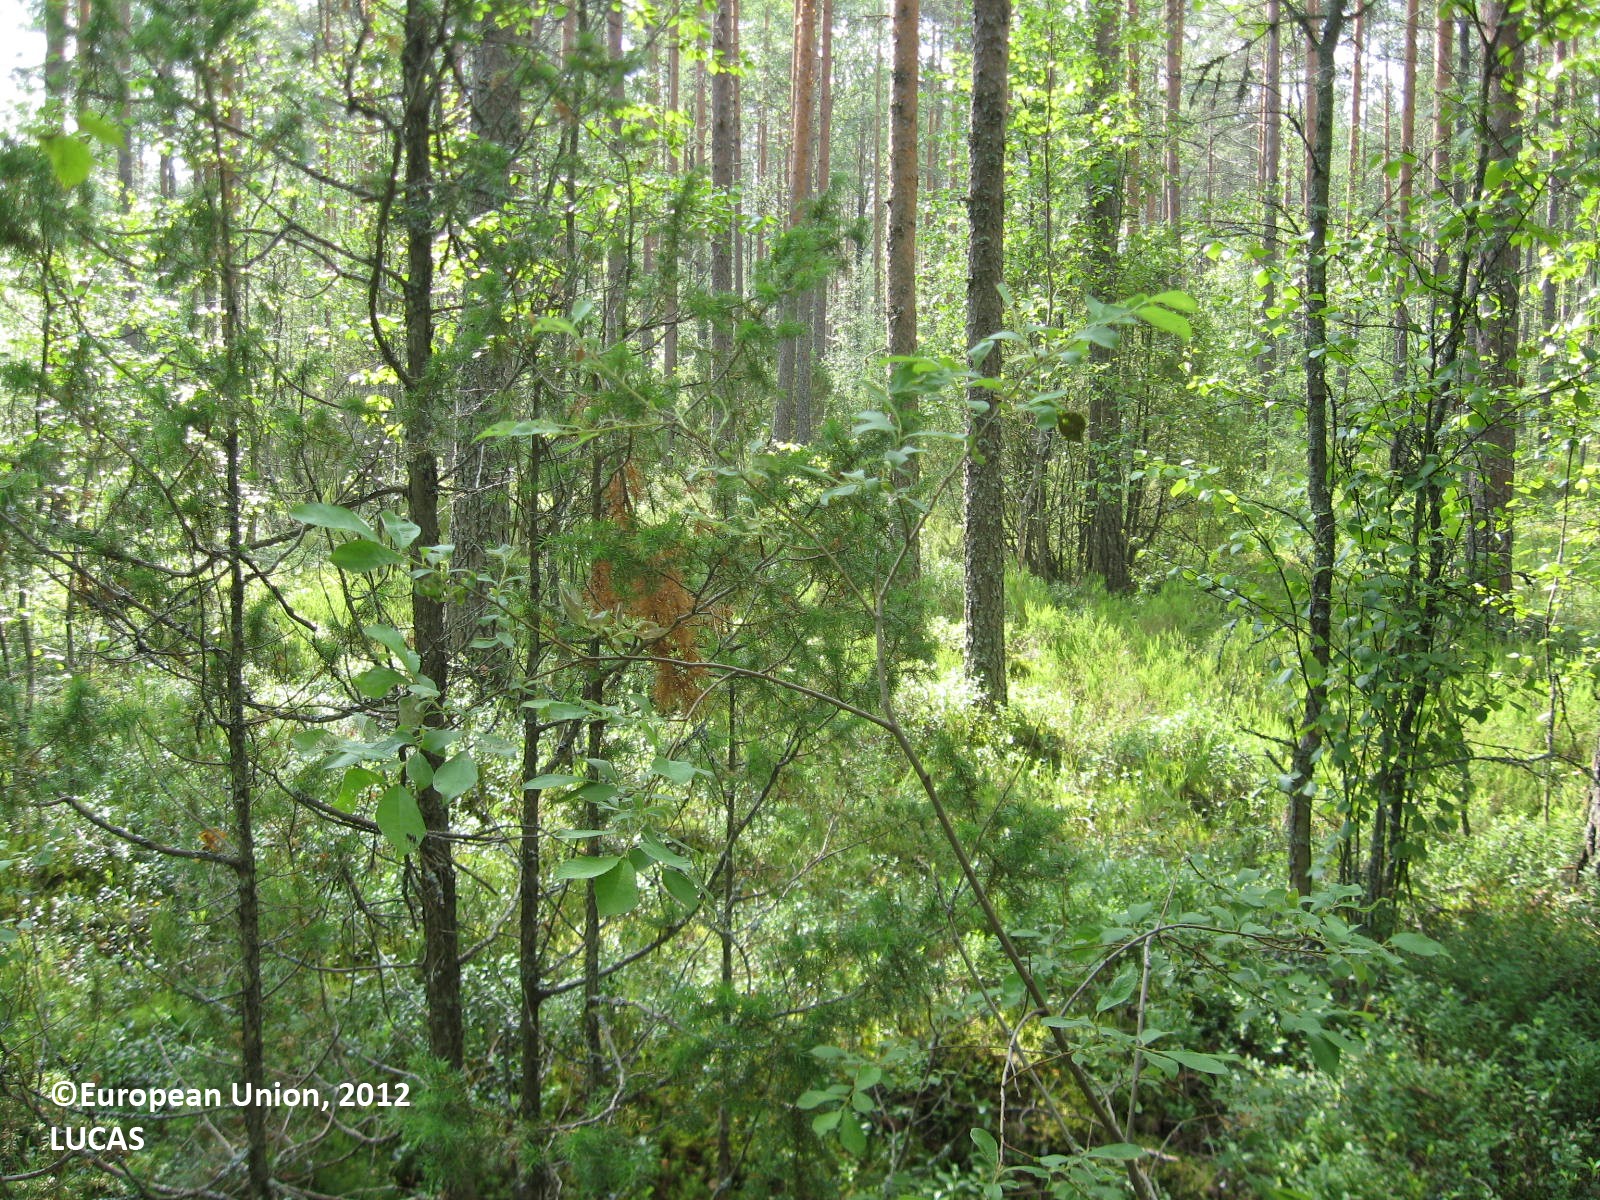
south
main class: Woodland
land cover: Pine dominated mixed woodland
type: boreal forest
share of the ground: > 75 %
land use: Forestry
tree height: > 5 m
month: July
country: FI
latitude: 61.8987
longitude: 22.3715
